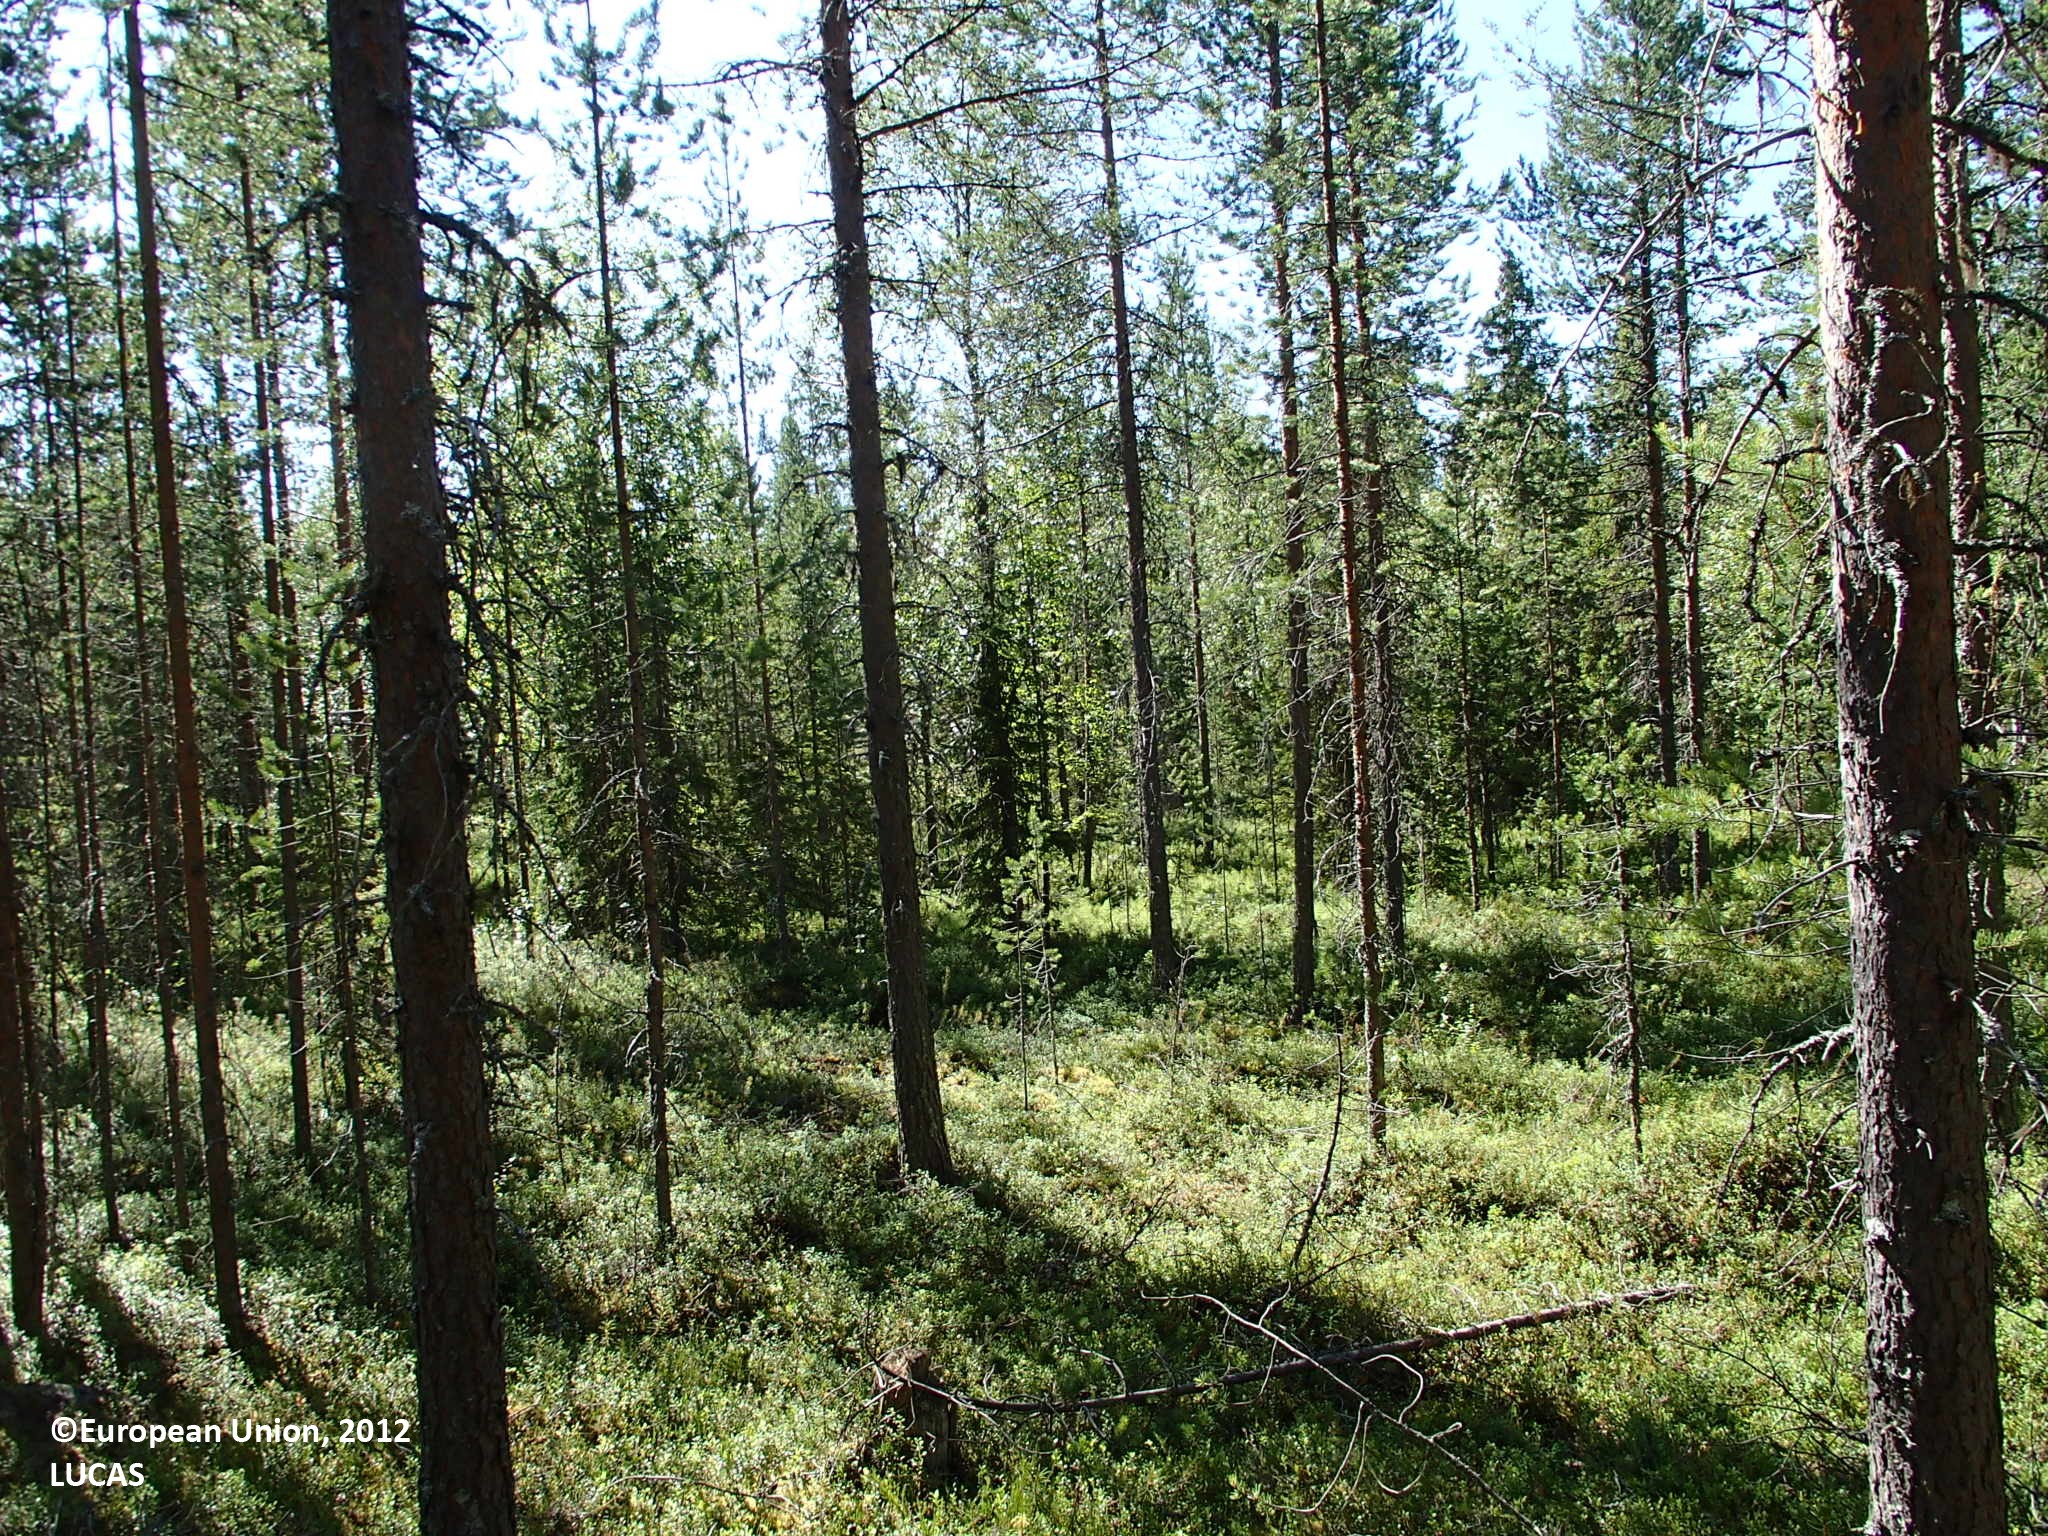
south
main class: Woodland
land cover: Pine dominated coniferous woodland
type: boreal forest
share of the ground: 50 - 75 %
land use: Forestry
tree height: > 5 m
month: July
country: FI
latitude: 66.8213
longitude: 25.4259
